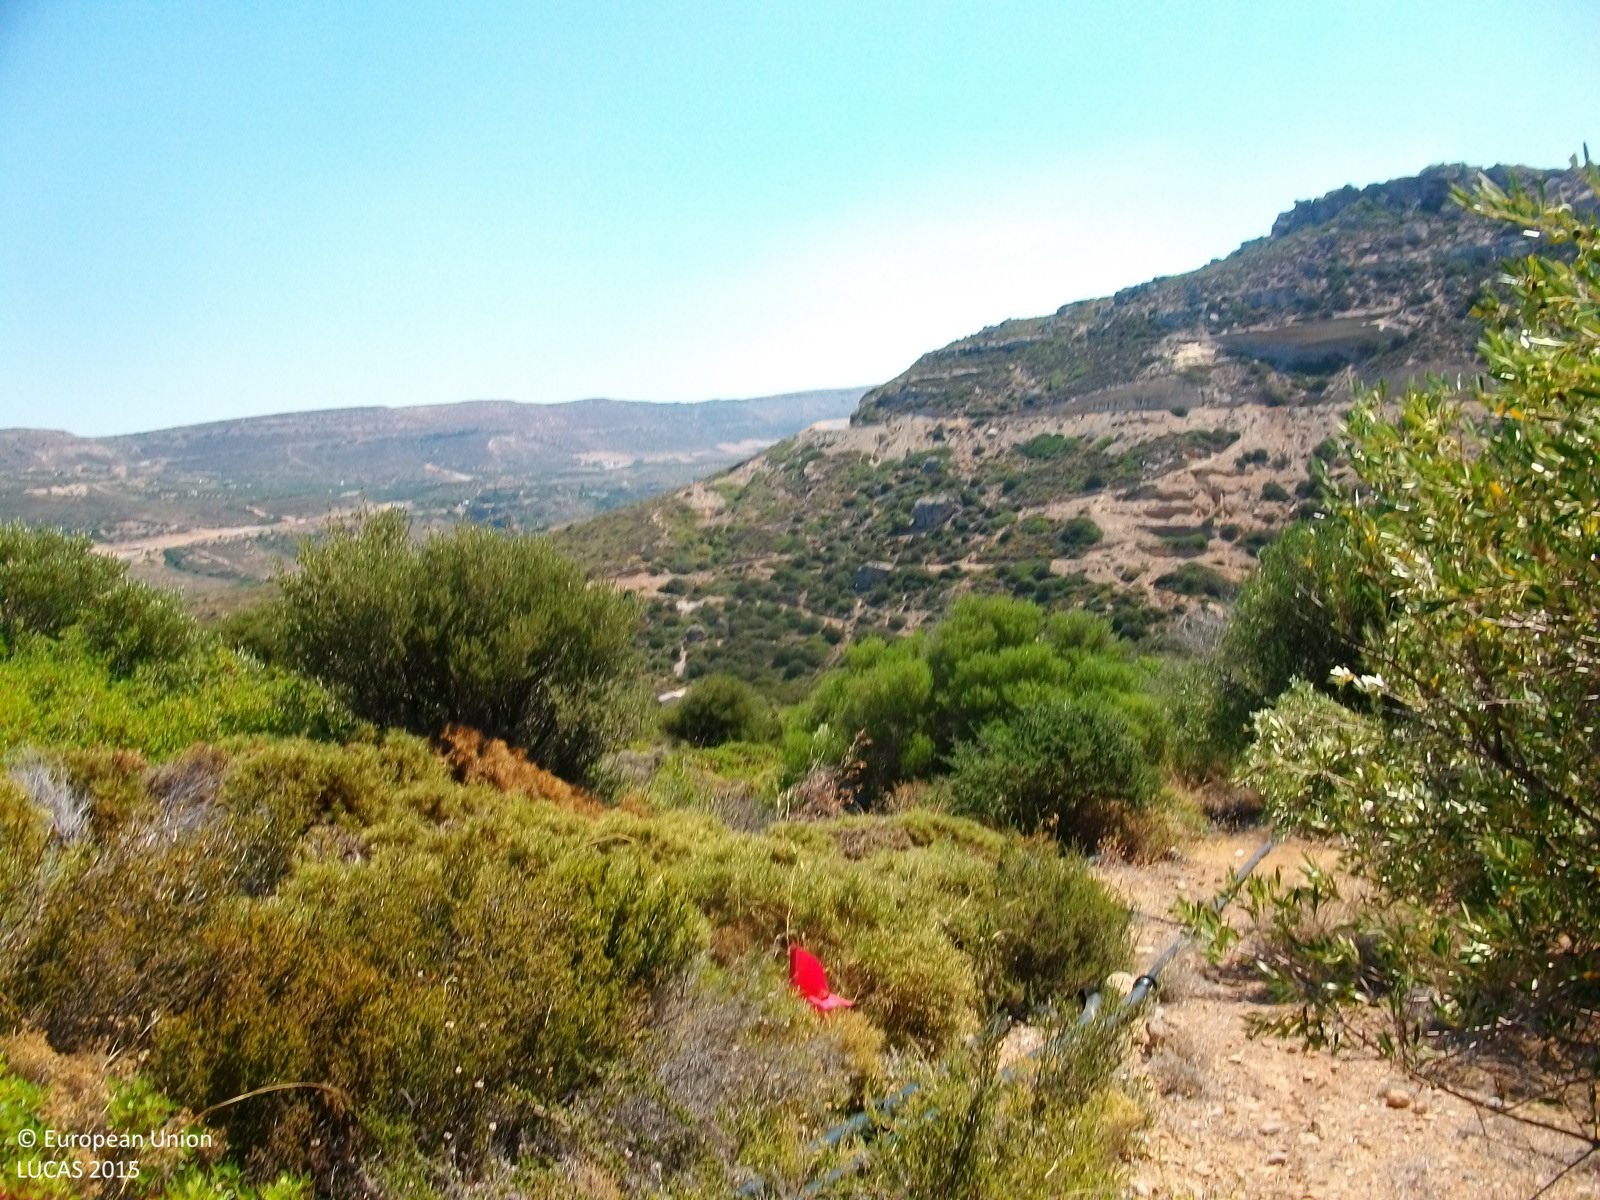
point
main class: Shrubland
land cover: Shrubland with sparse tree cover
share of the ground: > 75 %
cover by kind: shrubs 95 %, broadleaved forest trees 5 %
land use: Semi-natural and natural areas not in use
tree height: < 5 m
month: August
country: GR
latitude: 35.2065
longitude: 26.1838
